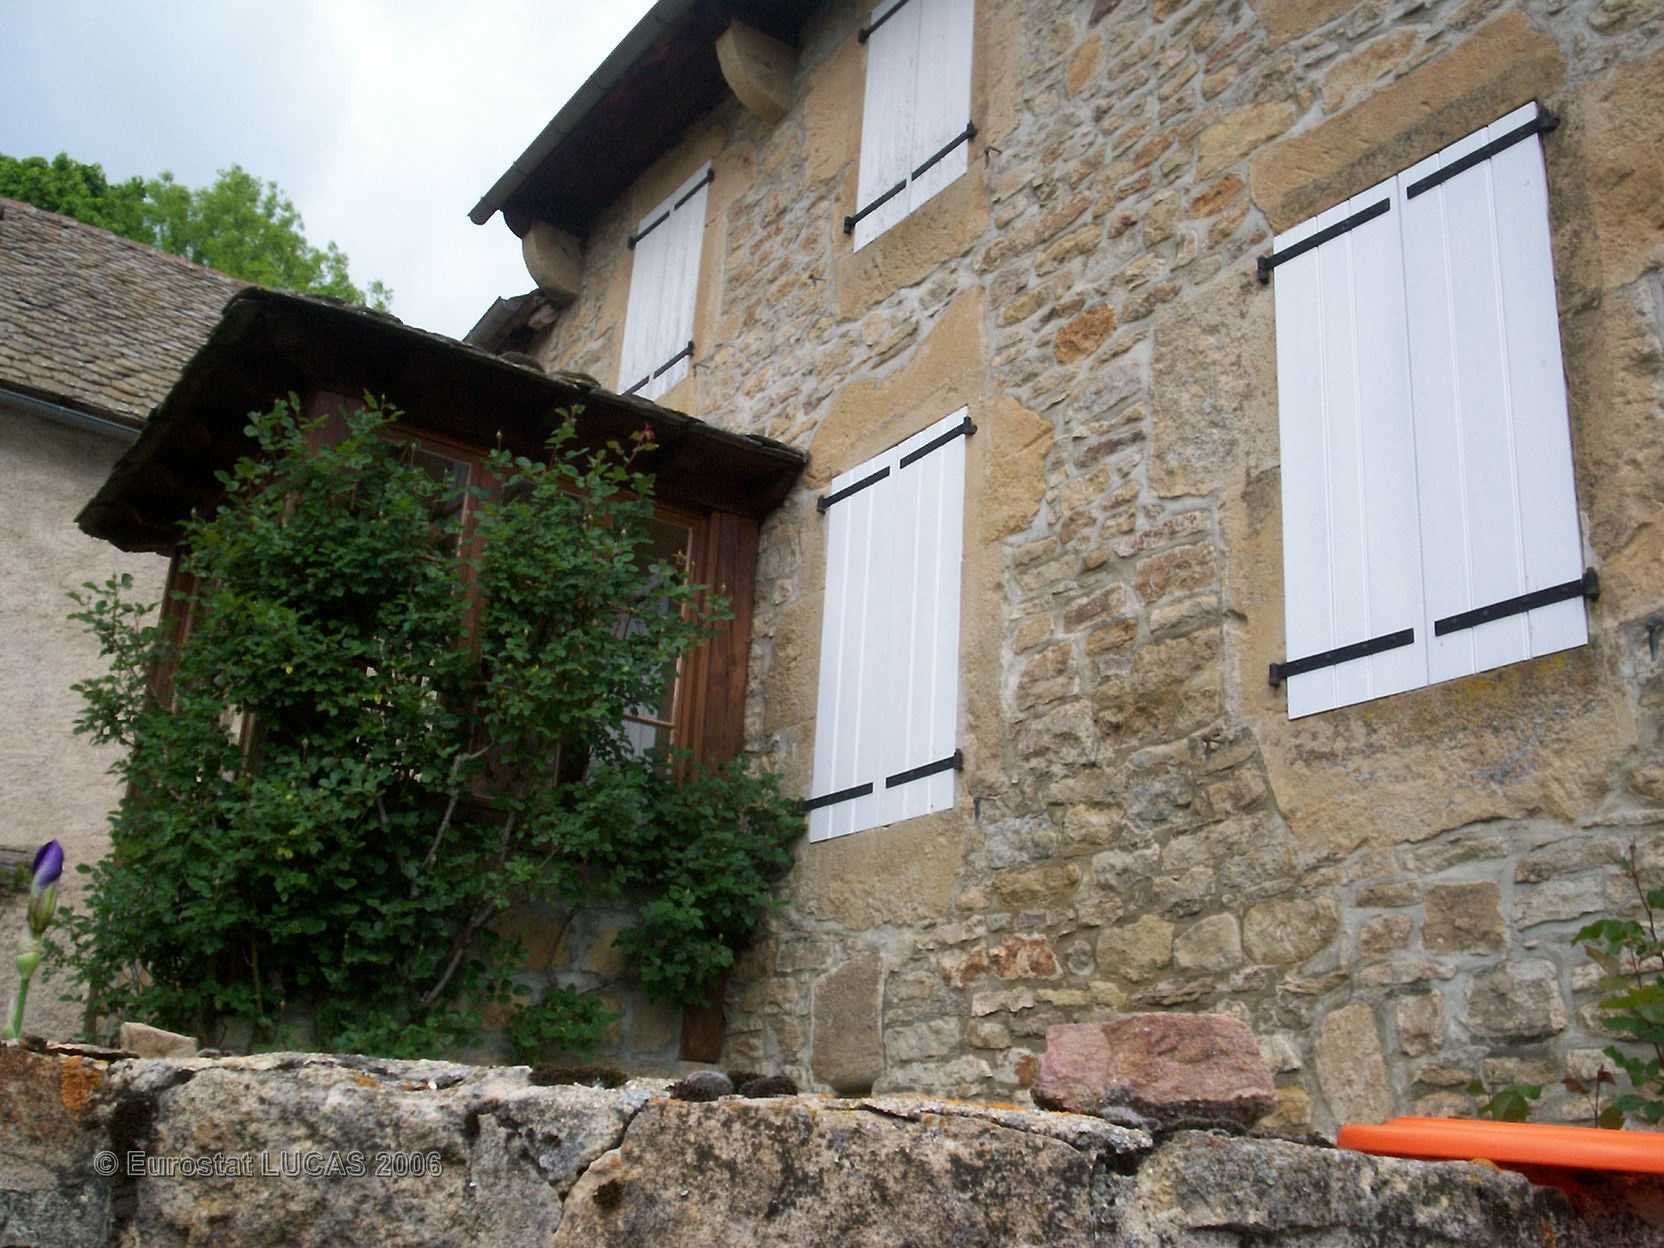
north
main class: Grassland
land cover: Grassland with sparse tree/shrub cover
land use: Residential
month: May
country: FR
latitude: 44.5904
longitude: 3.3663
